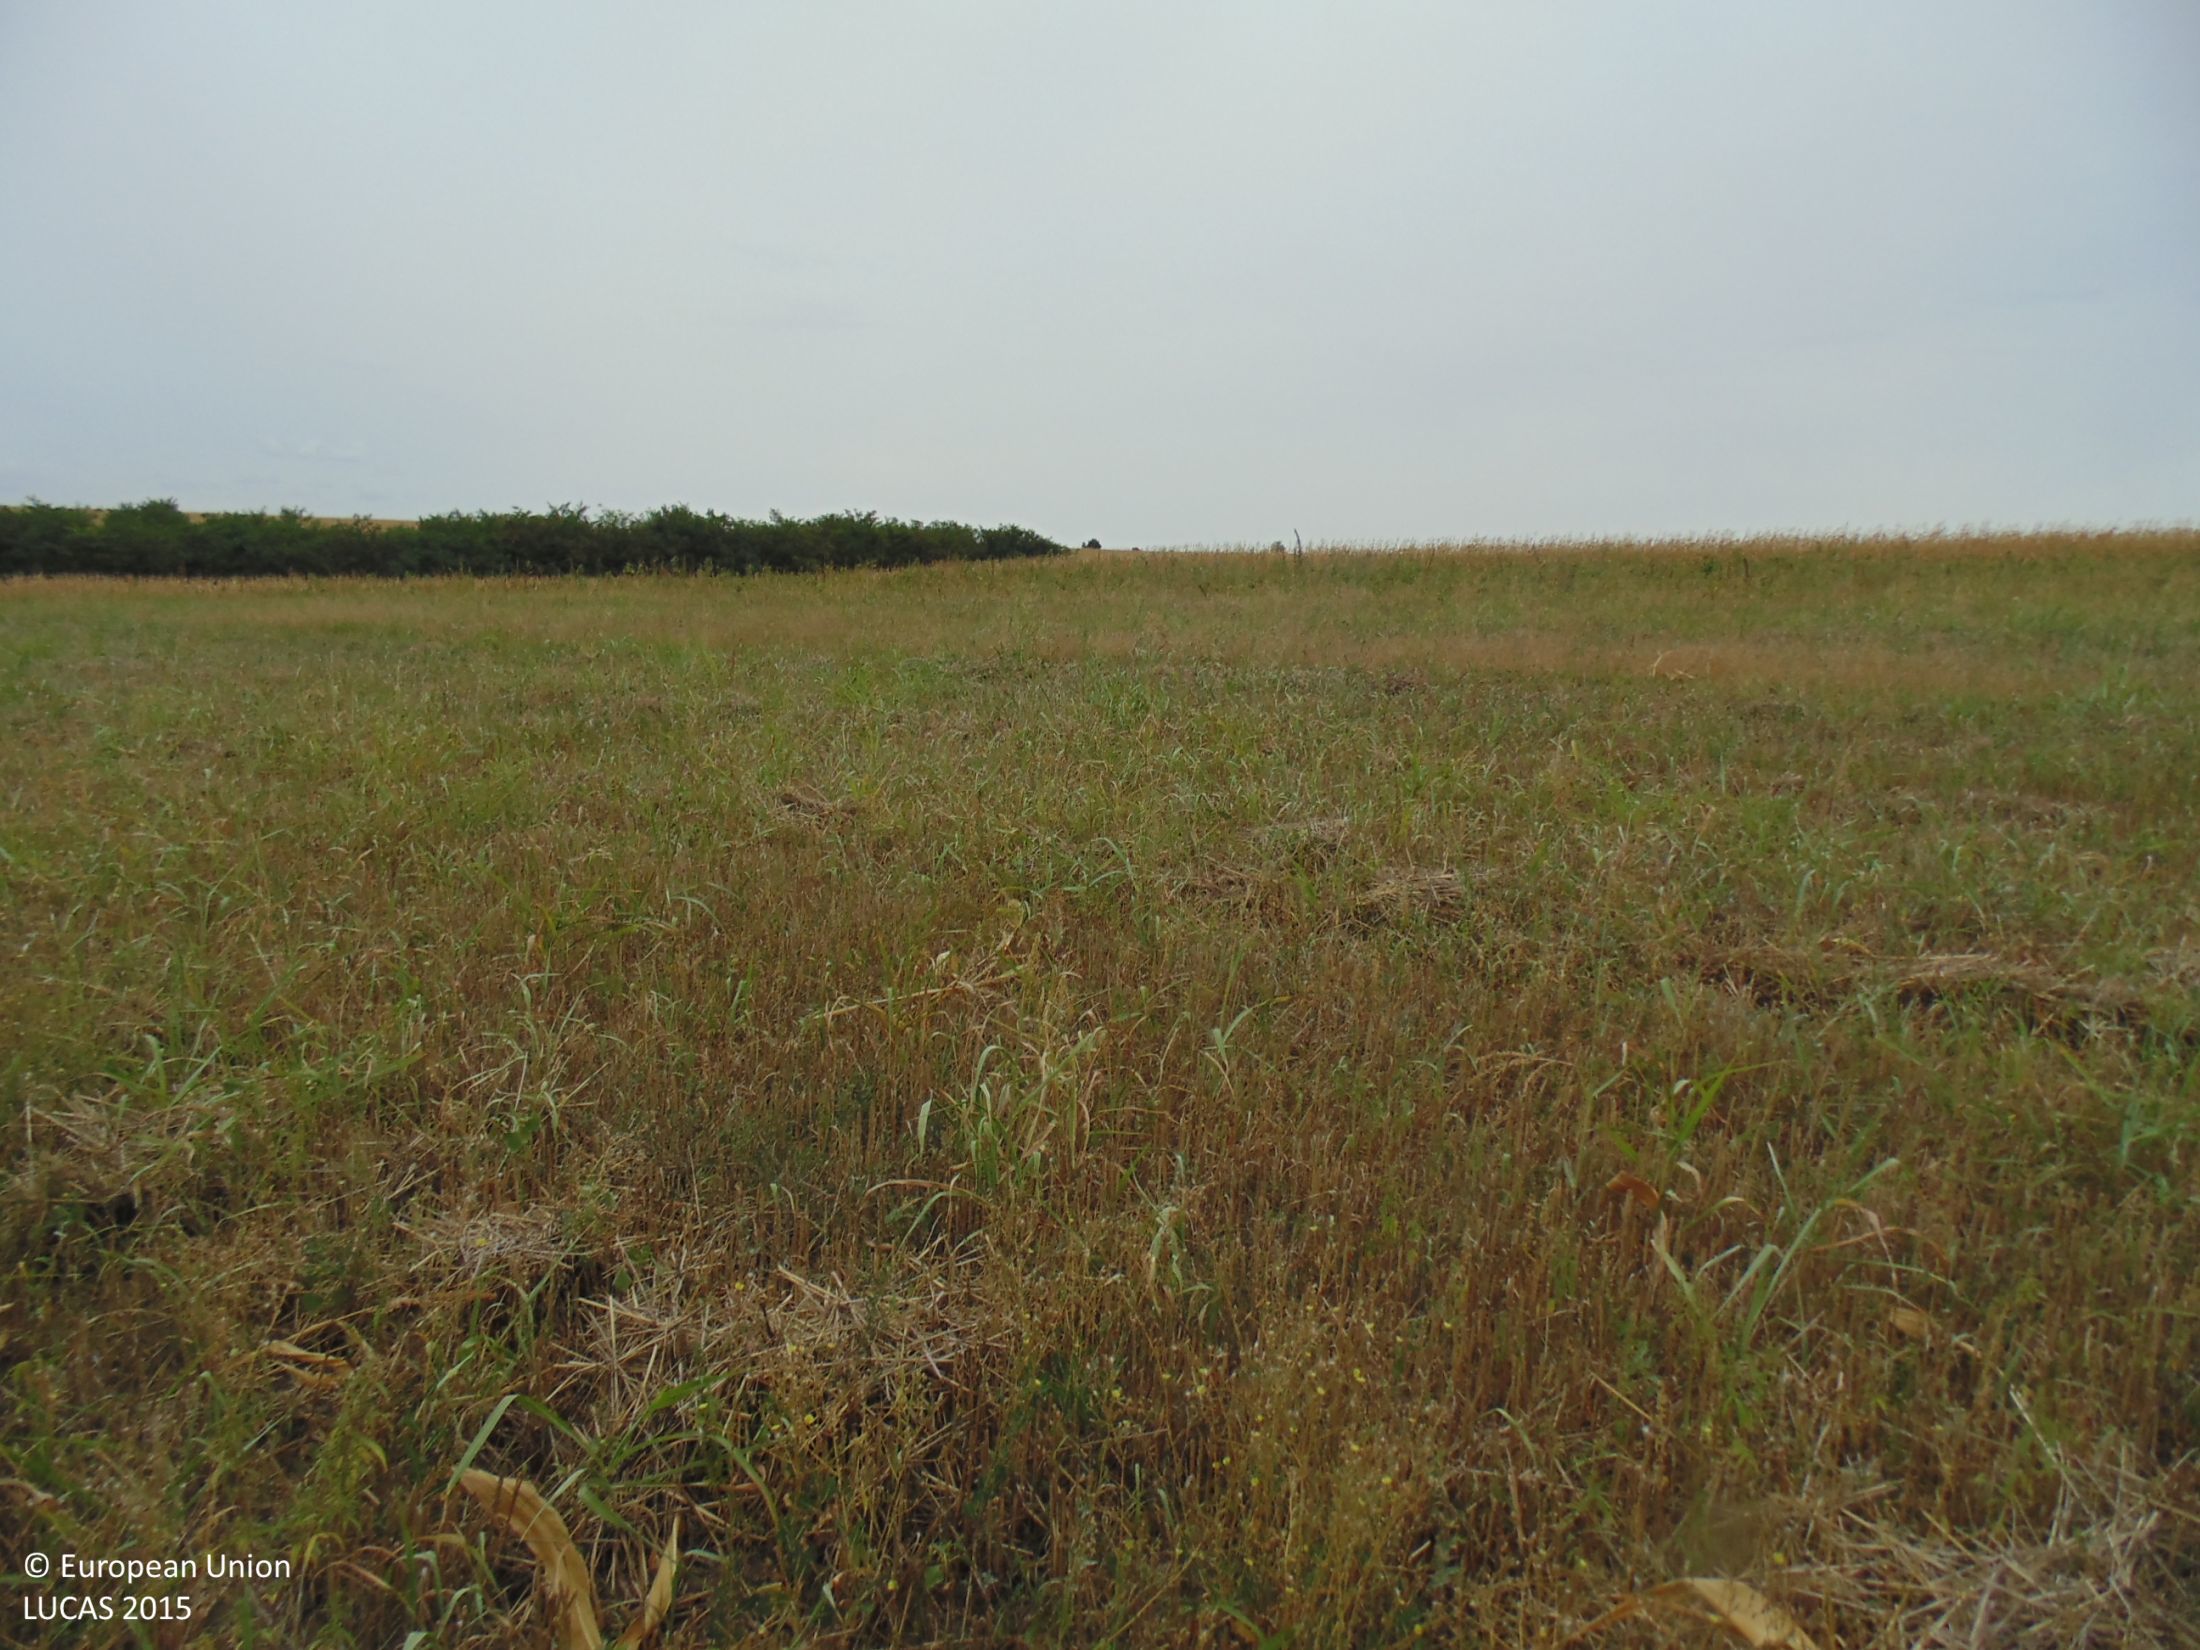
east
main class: Cropland
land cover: Maize
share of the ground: > 75 %
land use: Agriculture (excluding fallow land and kitchen gardens)
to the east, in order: Maize; Grass margins; Common wheat; Grass margins; Other fresh vegetables; Grass margins; Maize; Grass margins; Common wheat; Grass margins; Tracks; Grass margins; Maize; Grass margins; Broadleaved woodland; Grass margins; Maize
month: September
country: BG
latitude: 43.9557
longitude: 27.0597
